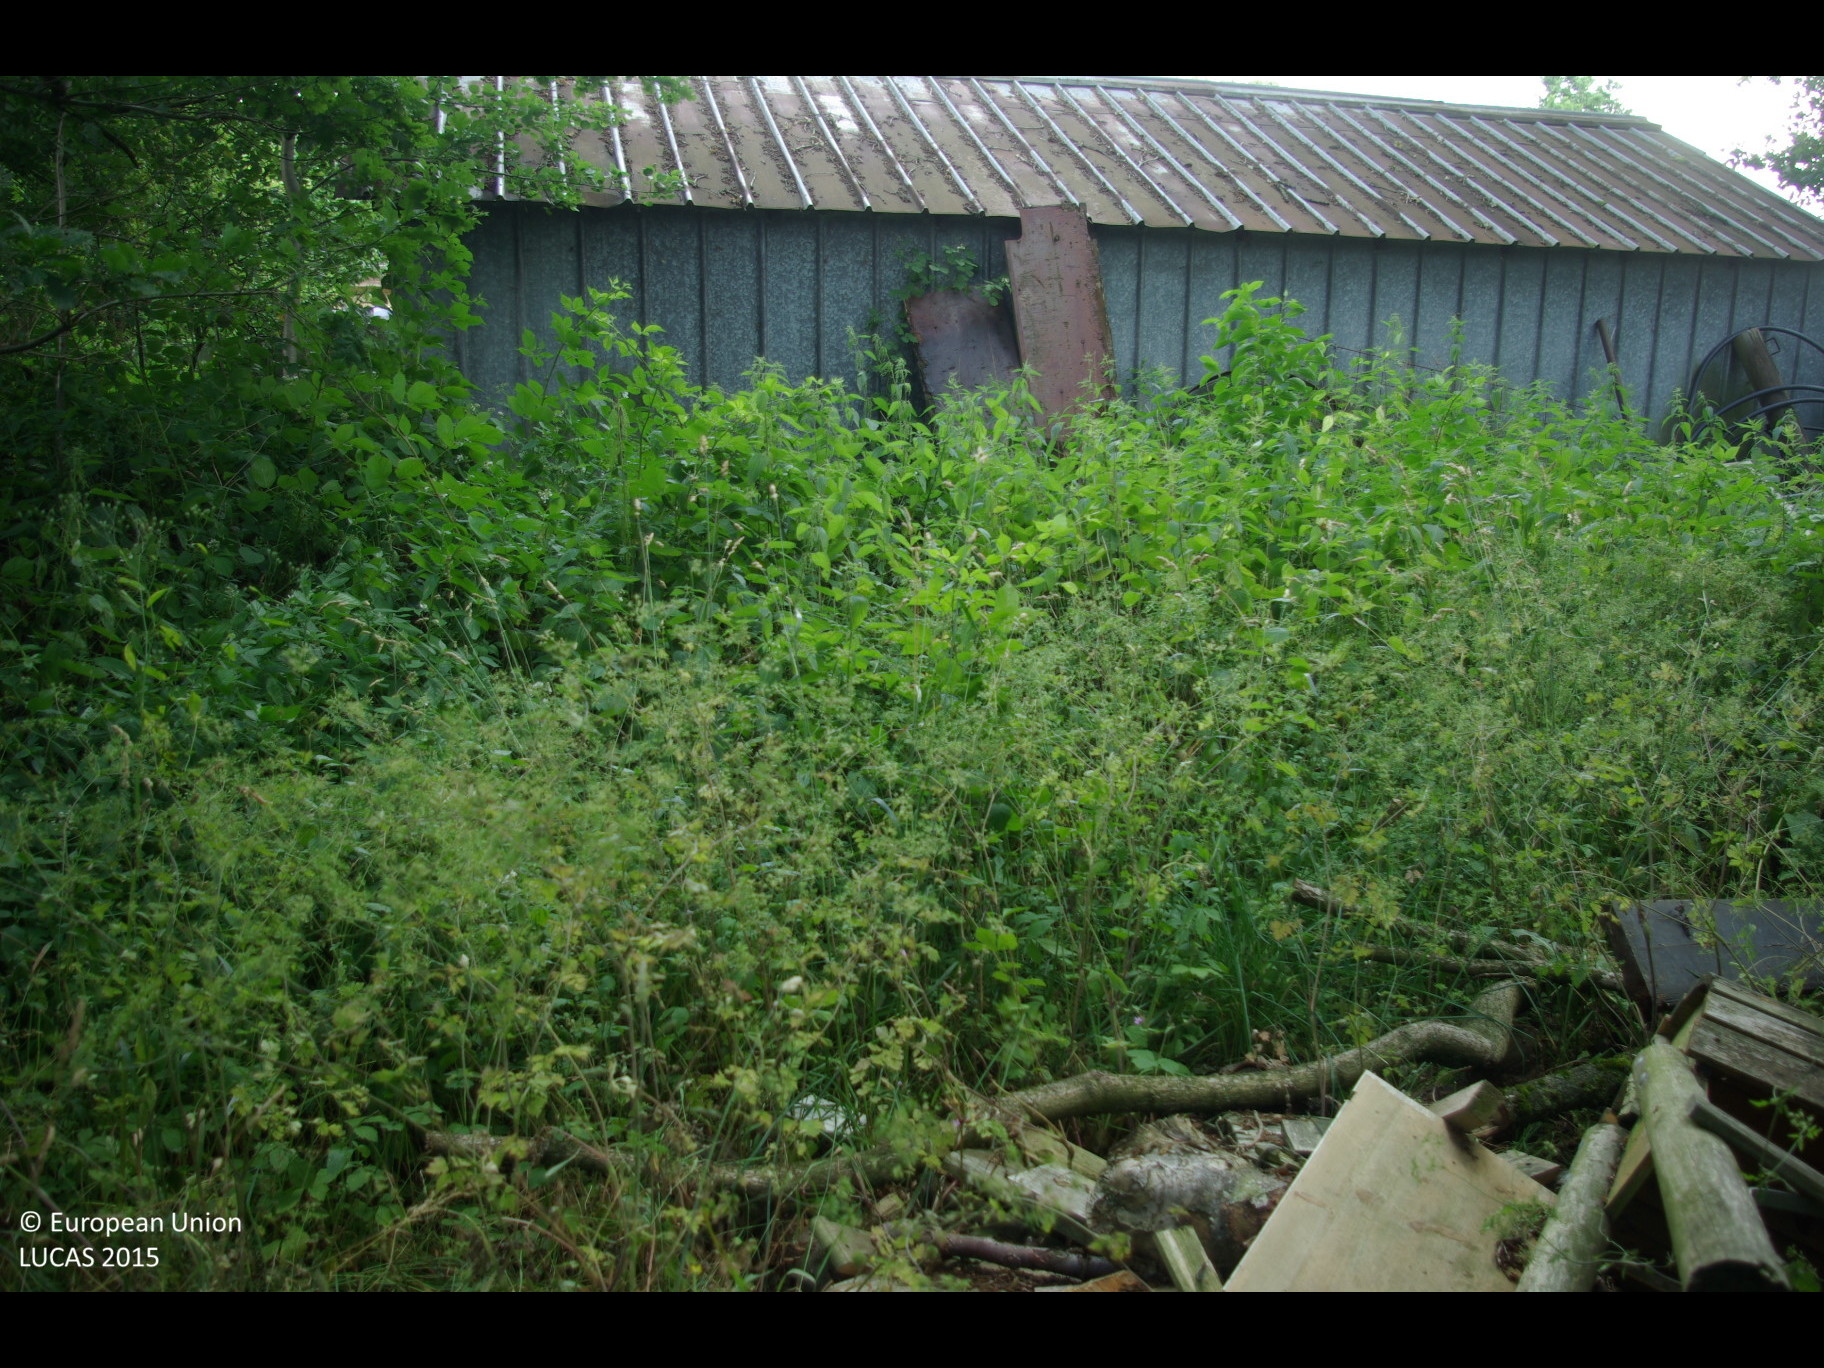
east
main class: Grassland
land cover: Spontaneously vegetated surfaces
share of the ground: > 75 %
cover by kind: herbaceous plants 100 %
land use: Residential
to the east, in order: Grass margins; Spontaneously vegetated surfaces; Artificial constructions in urban areas; Grassland without tree/shrub cover; Grassland with sparse tree/shrub cover; Lines of trees; Grass margins; Paved roads, cycling and walking lanes; Grass margins; Grassland with sparse tree/shrub cover; Maize; Spontaneously vegetated surfaces; Tracks; Shruby margins; Maize
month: July
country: DE
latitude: 54.6932
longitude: 9.1783
